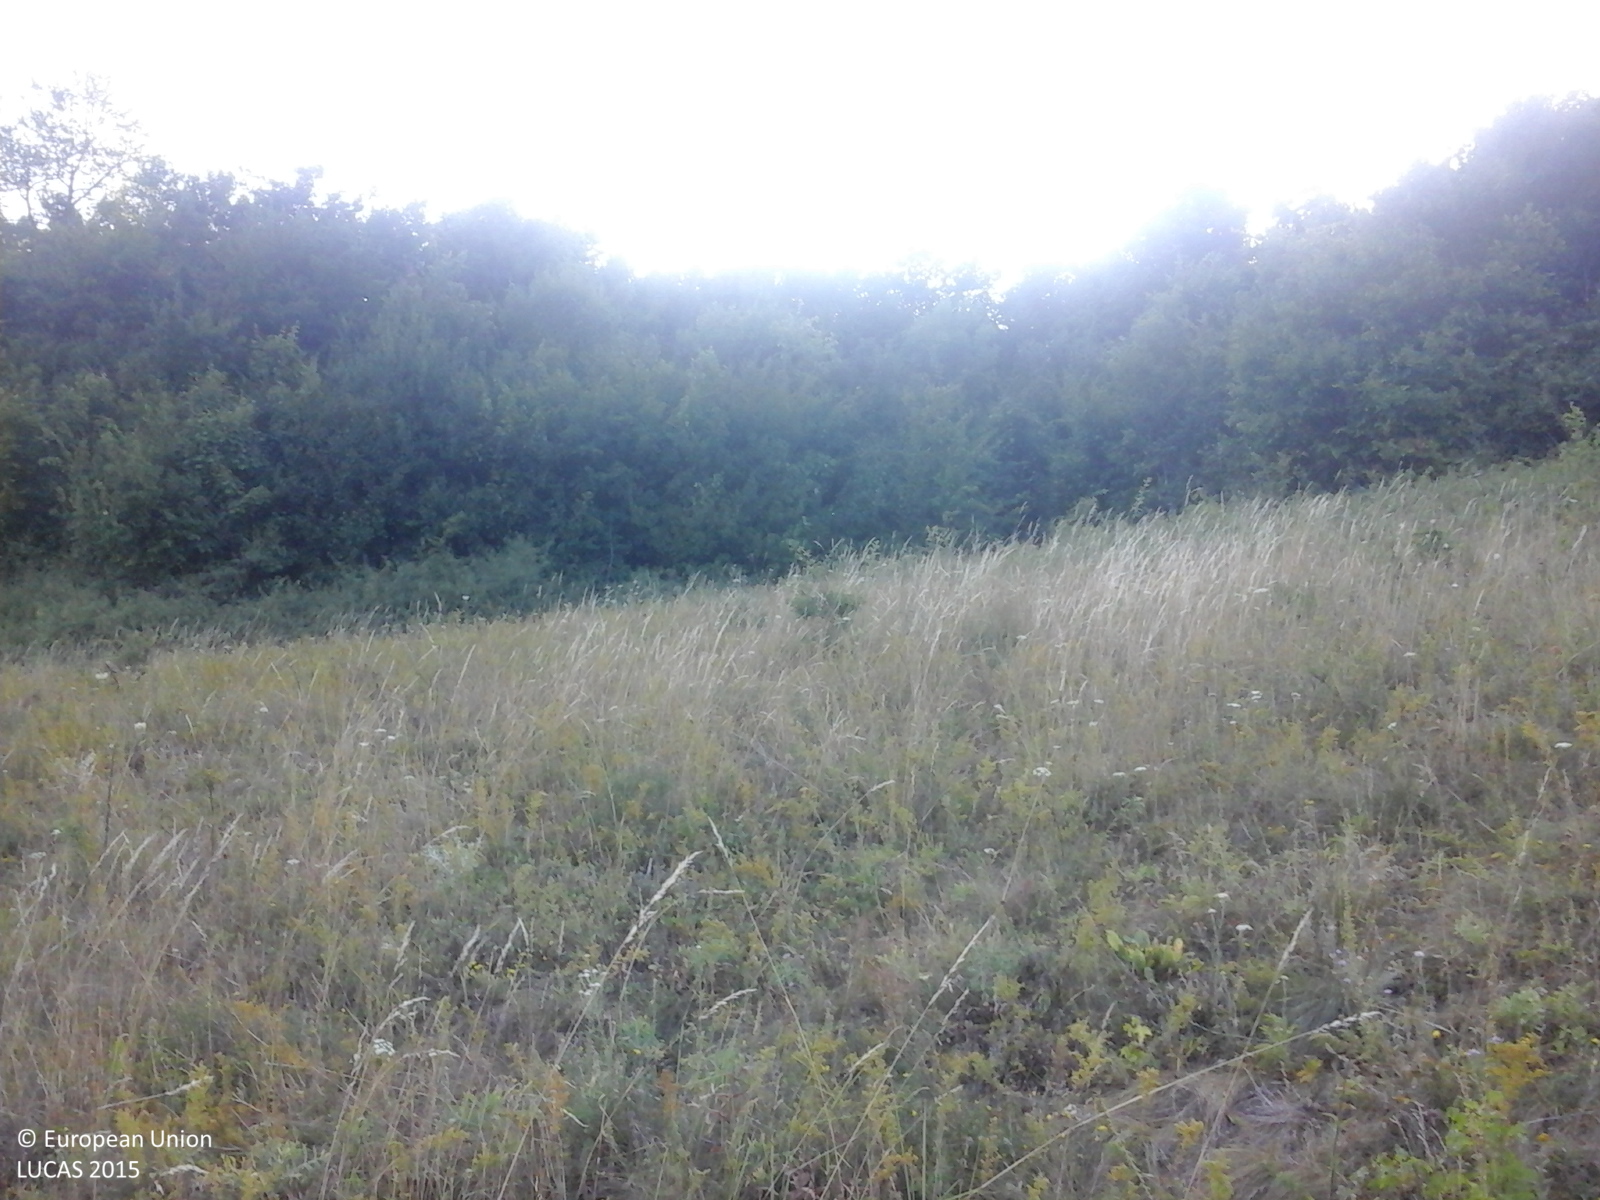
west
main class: Grassland
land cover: Grassland with sparse tree/shrub cover
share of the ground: > 75 %
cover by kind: herbaceous plants 85 %, shrubs 10 %, broadleaved forest trees 5 %
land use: Agriculture (excluding fallow land and kitchen gardens)
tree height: > 5 m
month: July
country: RO
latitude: 46.4971
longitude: 27.1561
